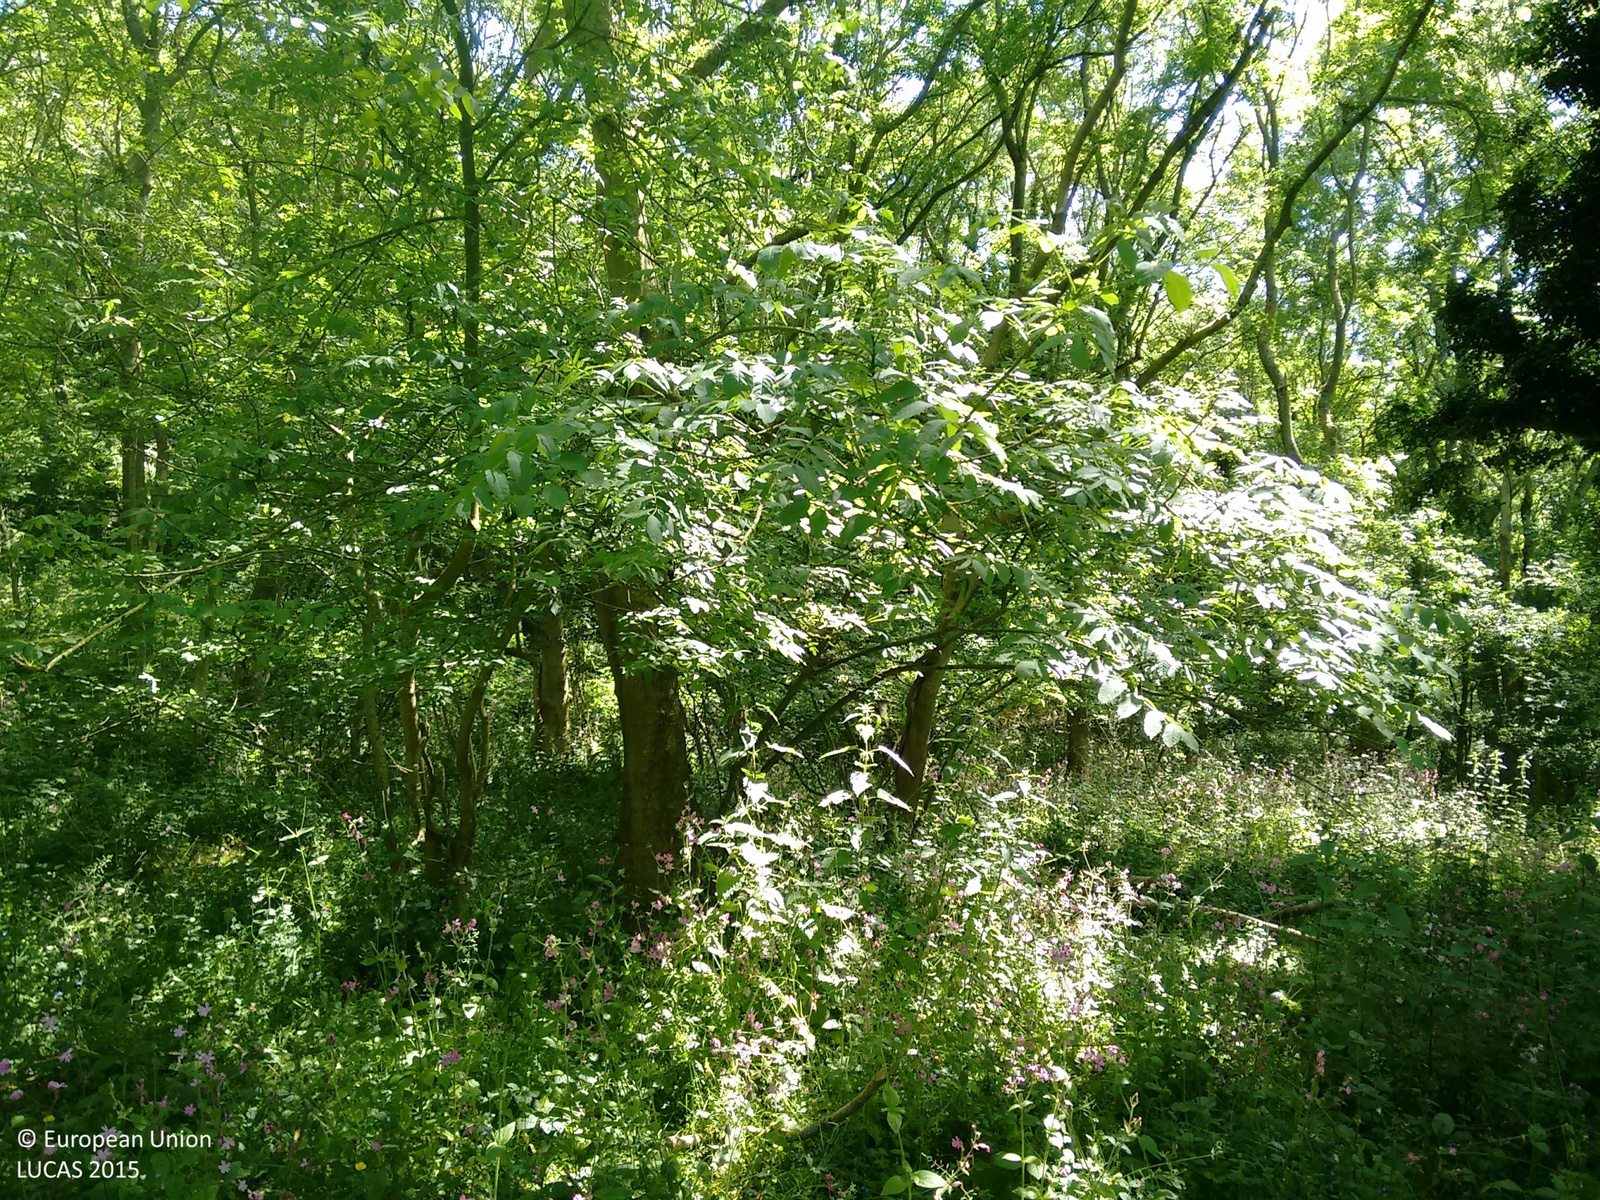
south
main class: Woodland
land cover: Broadleaved woodland
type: mesophytic deciduous forest
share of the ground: > 75 %
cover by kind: broadleaved forest trees 75 %, shrubs 15 %, herbaceous plants 10 %
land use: Semi-natural and natural areas not in use
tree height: > 5 m
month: June
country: GB
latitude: 50.7956
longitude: 0.2229
